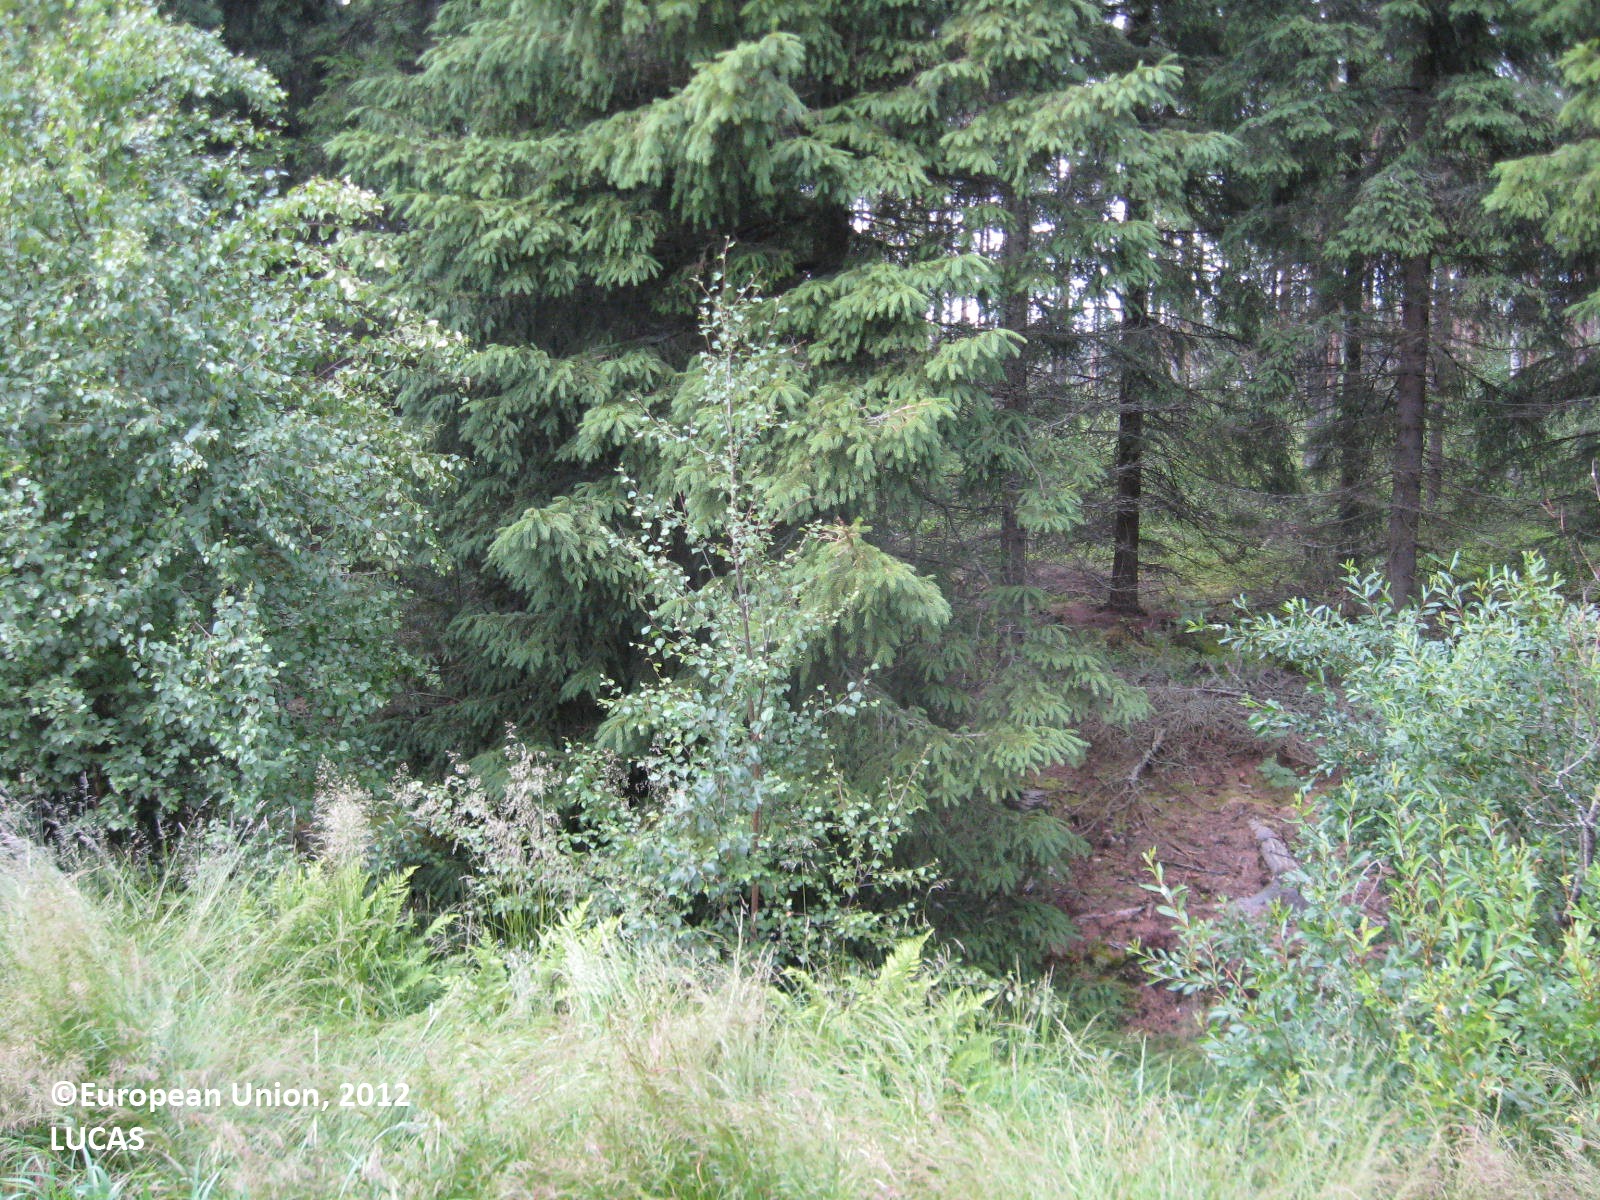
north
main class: Cropland
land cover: Oats
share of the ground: > 75 %
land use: Agriculture (excluding fallow land and kitchen gardens)
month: July
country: FI
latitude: 62.3811
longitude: 22.7247
